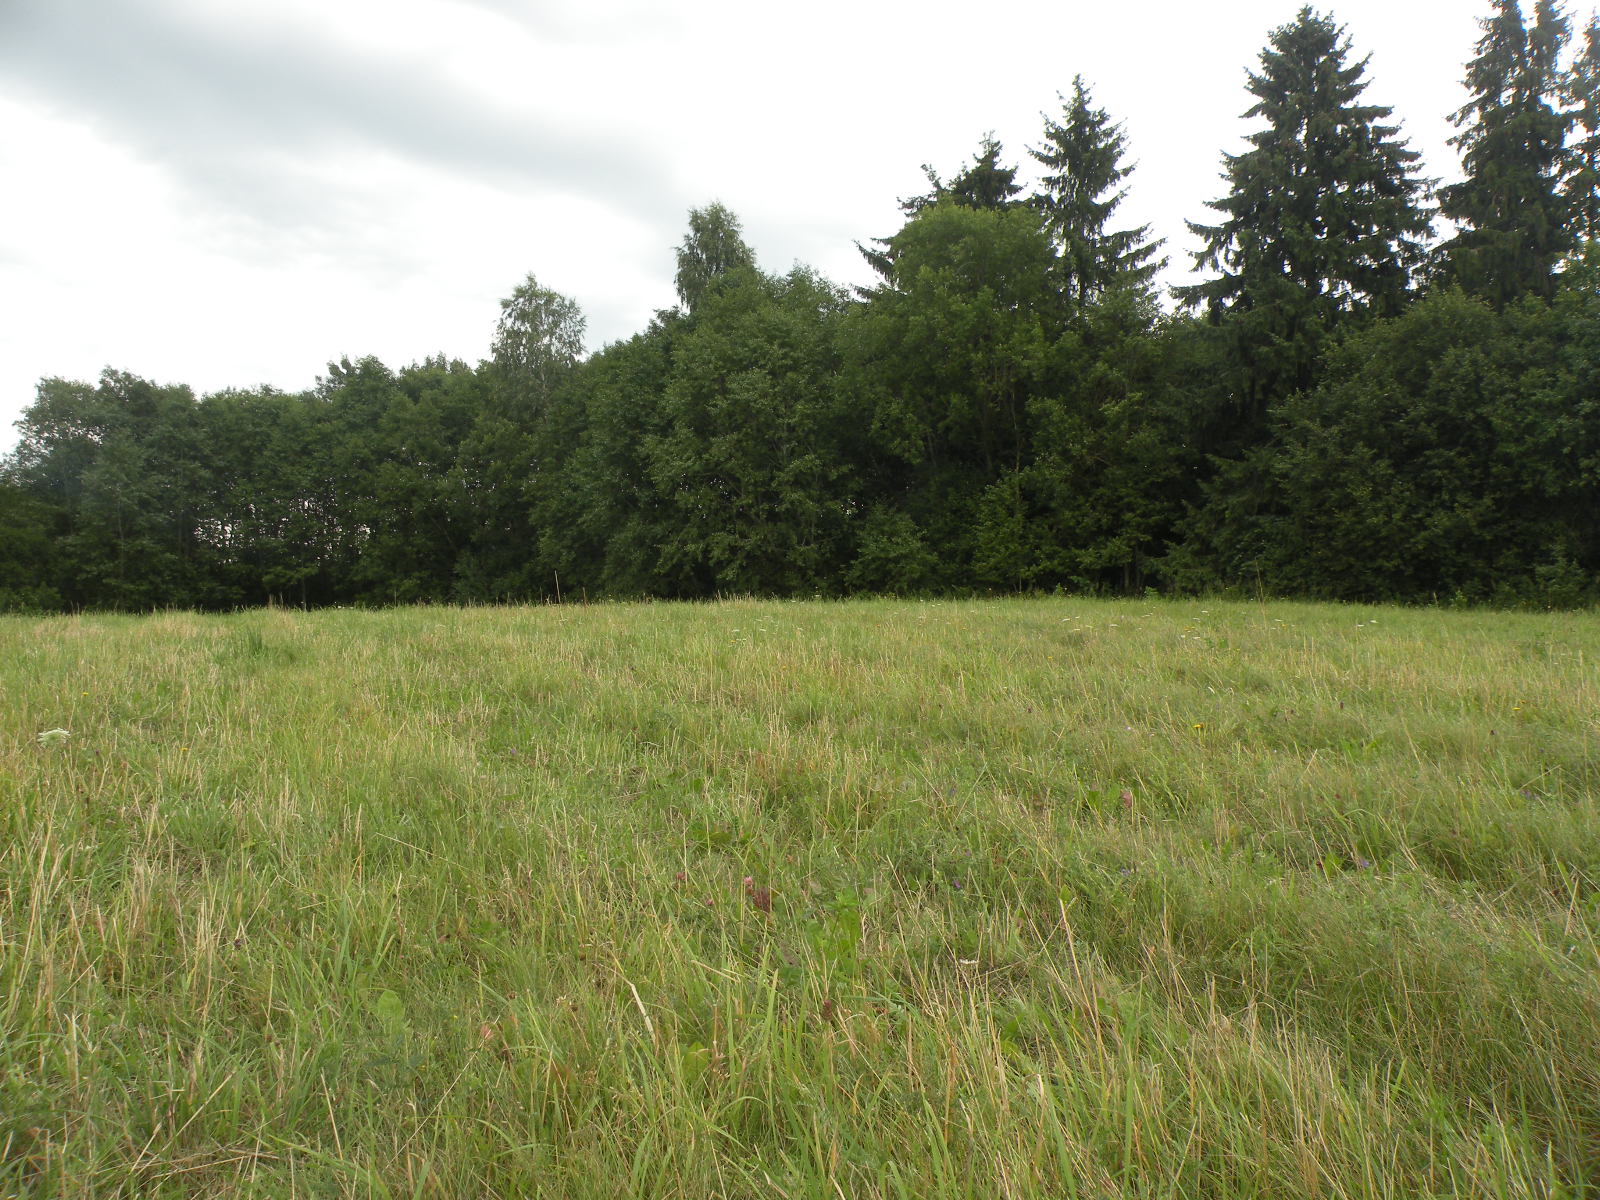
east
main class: Grassland
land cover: Grassland without tree/shrub cover
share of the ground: > 75 %
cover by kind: herbaceous plants 100 %
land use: Agriculture (excluding fallow land and kitchen gardens)
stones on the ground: < 10 %
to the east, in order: Grassland without tree/shrub cover; Broadleaved woodland; Grassland without tree/shrub cover; Inland fresh water bodies; Grassland without tree/shrub cover
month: July
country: LV
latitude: 55.8573
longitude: 26.9552
